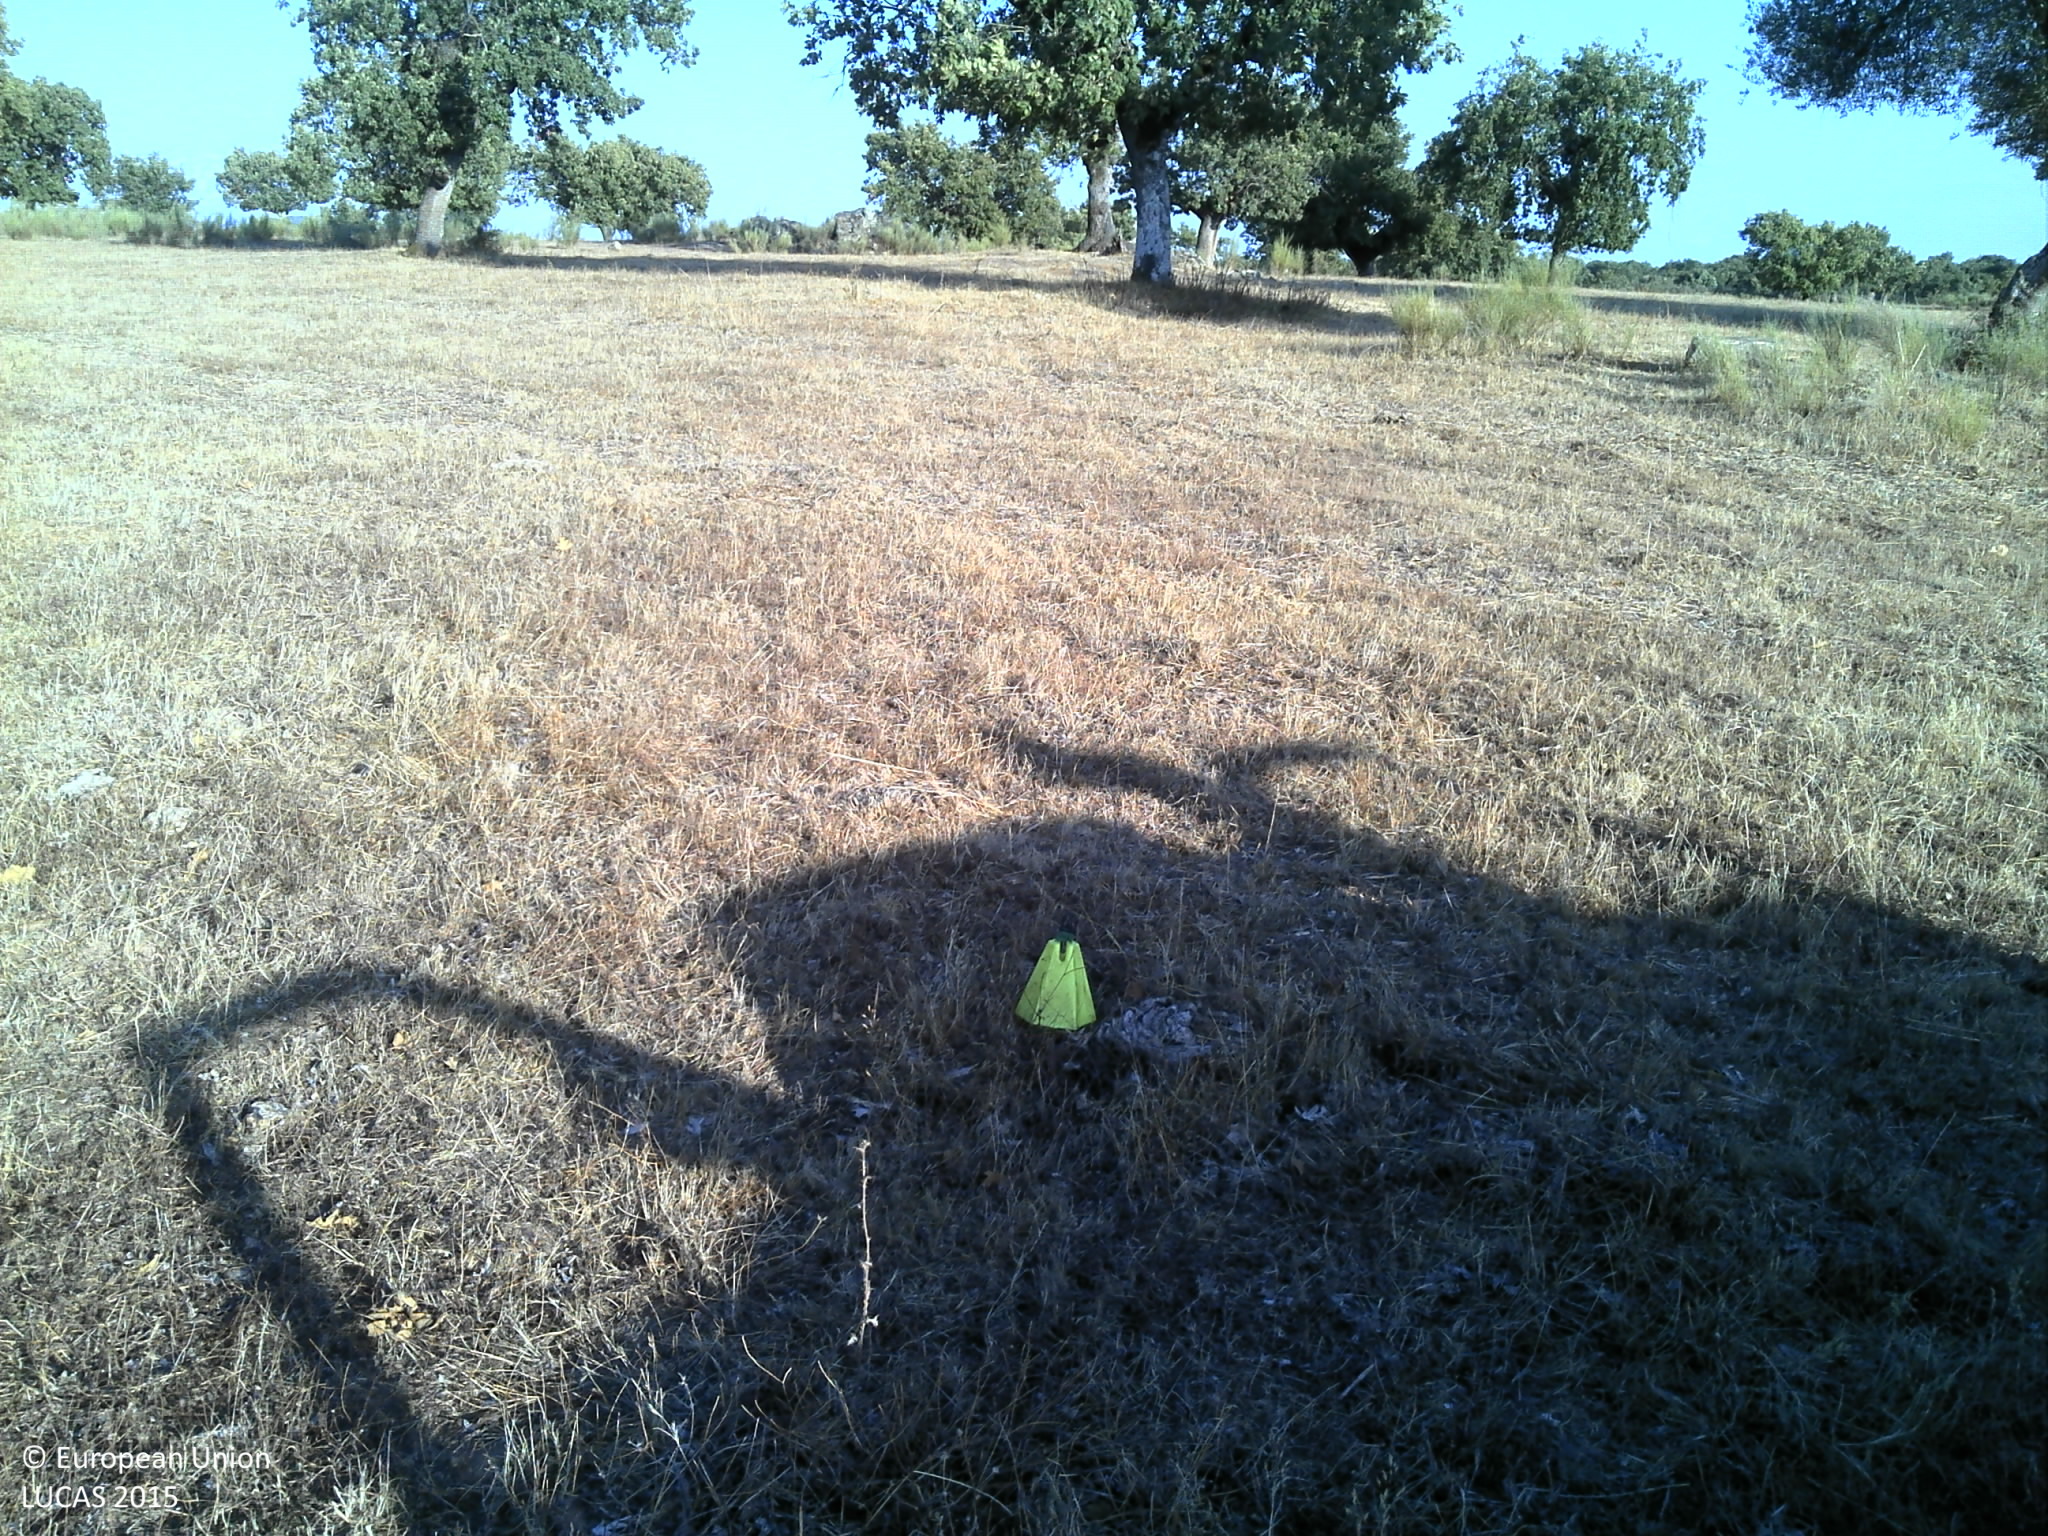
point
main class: Woodland
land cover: Broadleaved woodland
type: broadleaved evergreen forest
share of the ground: 10 - 25 %
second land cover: Grassland without tree/shrub cover
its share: 10 - 25 %
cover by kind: unconsolidated bare surface 80 %, broadleaved forest trees 10 %, herbaceous plants 10 %
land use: Forestry
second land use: Agriculture (excluding fallow land and kitchen gardens)
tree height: > 5 m
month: August
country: PT
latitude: 39.3533
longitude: -7.5569
